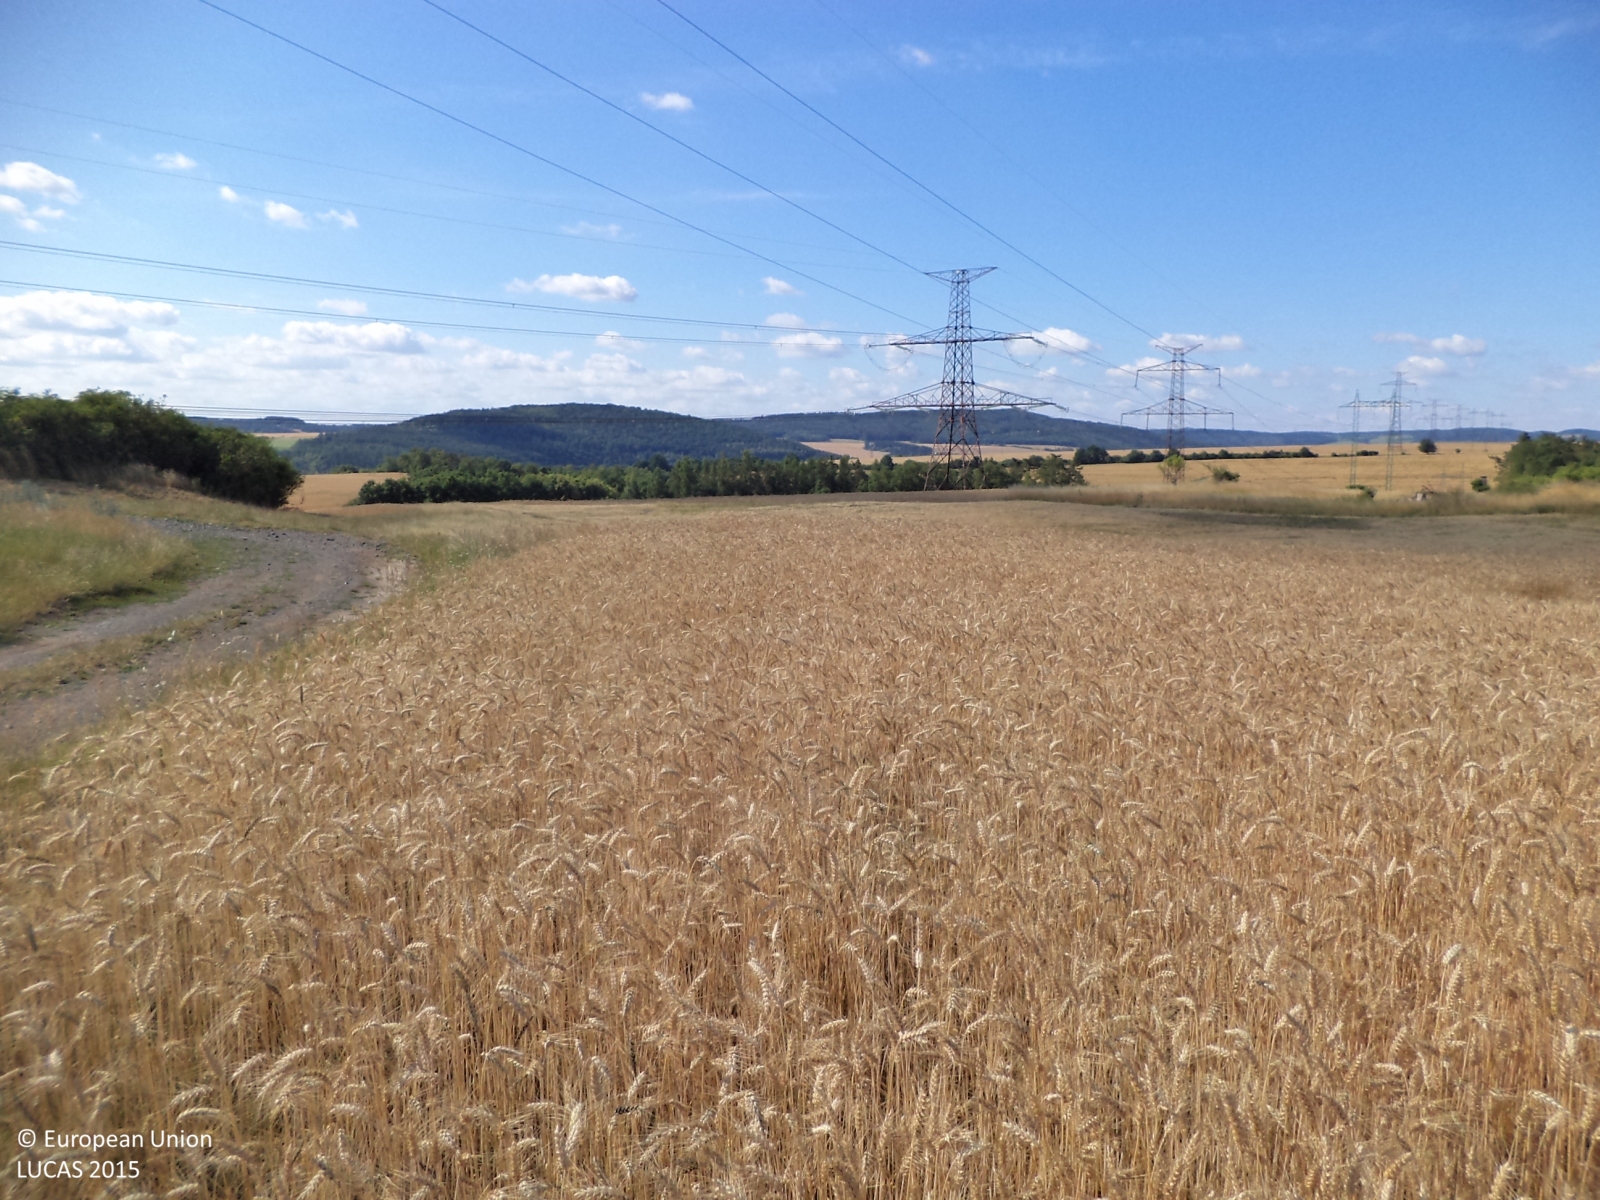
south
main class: Cropland
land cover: Common wheat
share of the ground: > 75 %
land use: Agriculture (excluding fallow land and kitchen gardens)
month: July
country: CZ
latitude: 49.8321
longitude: 14.3250
